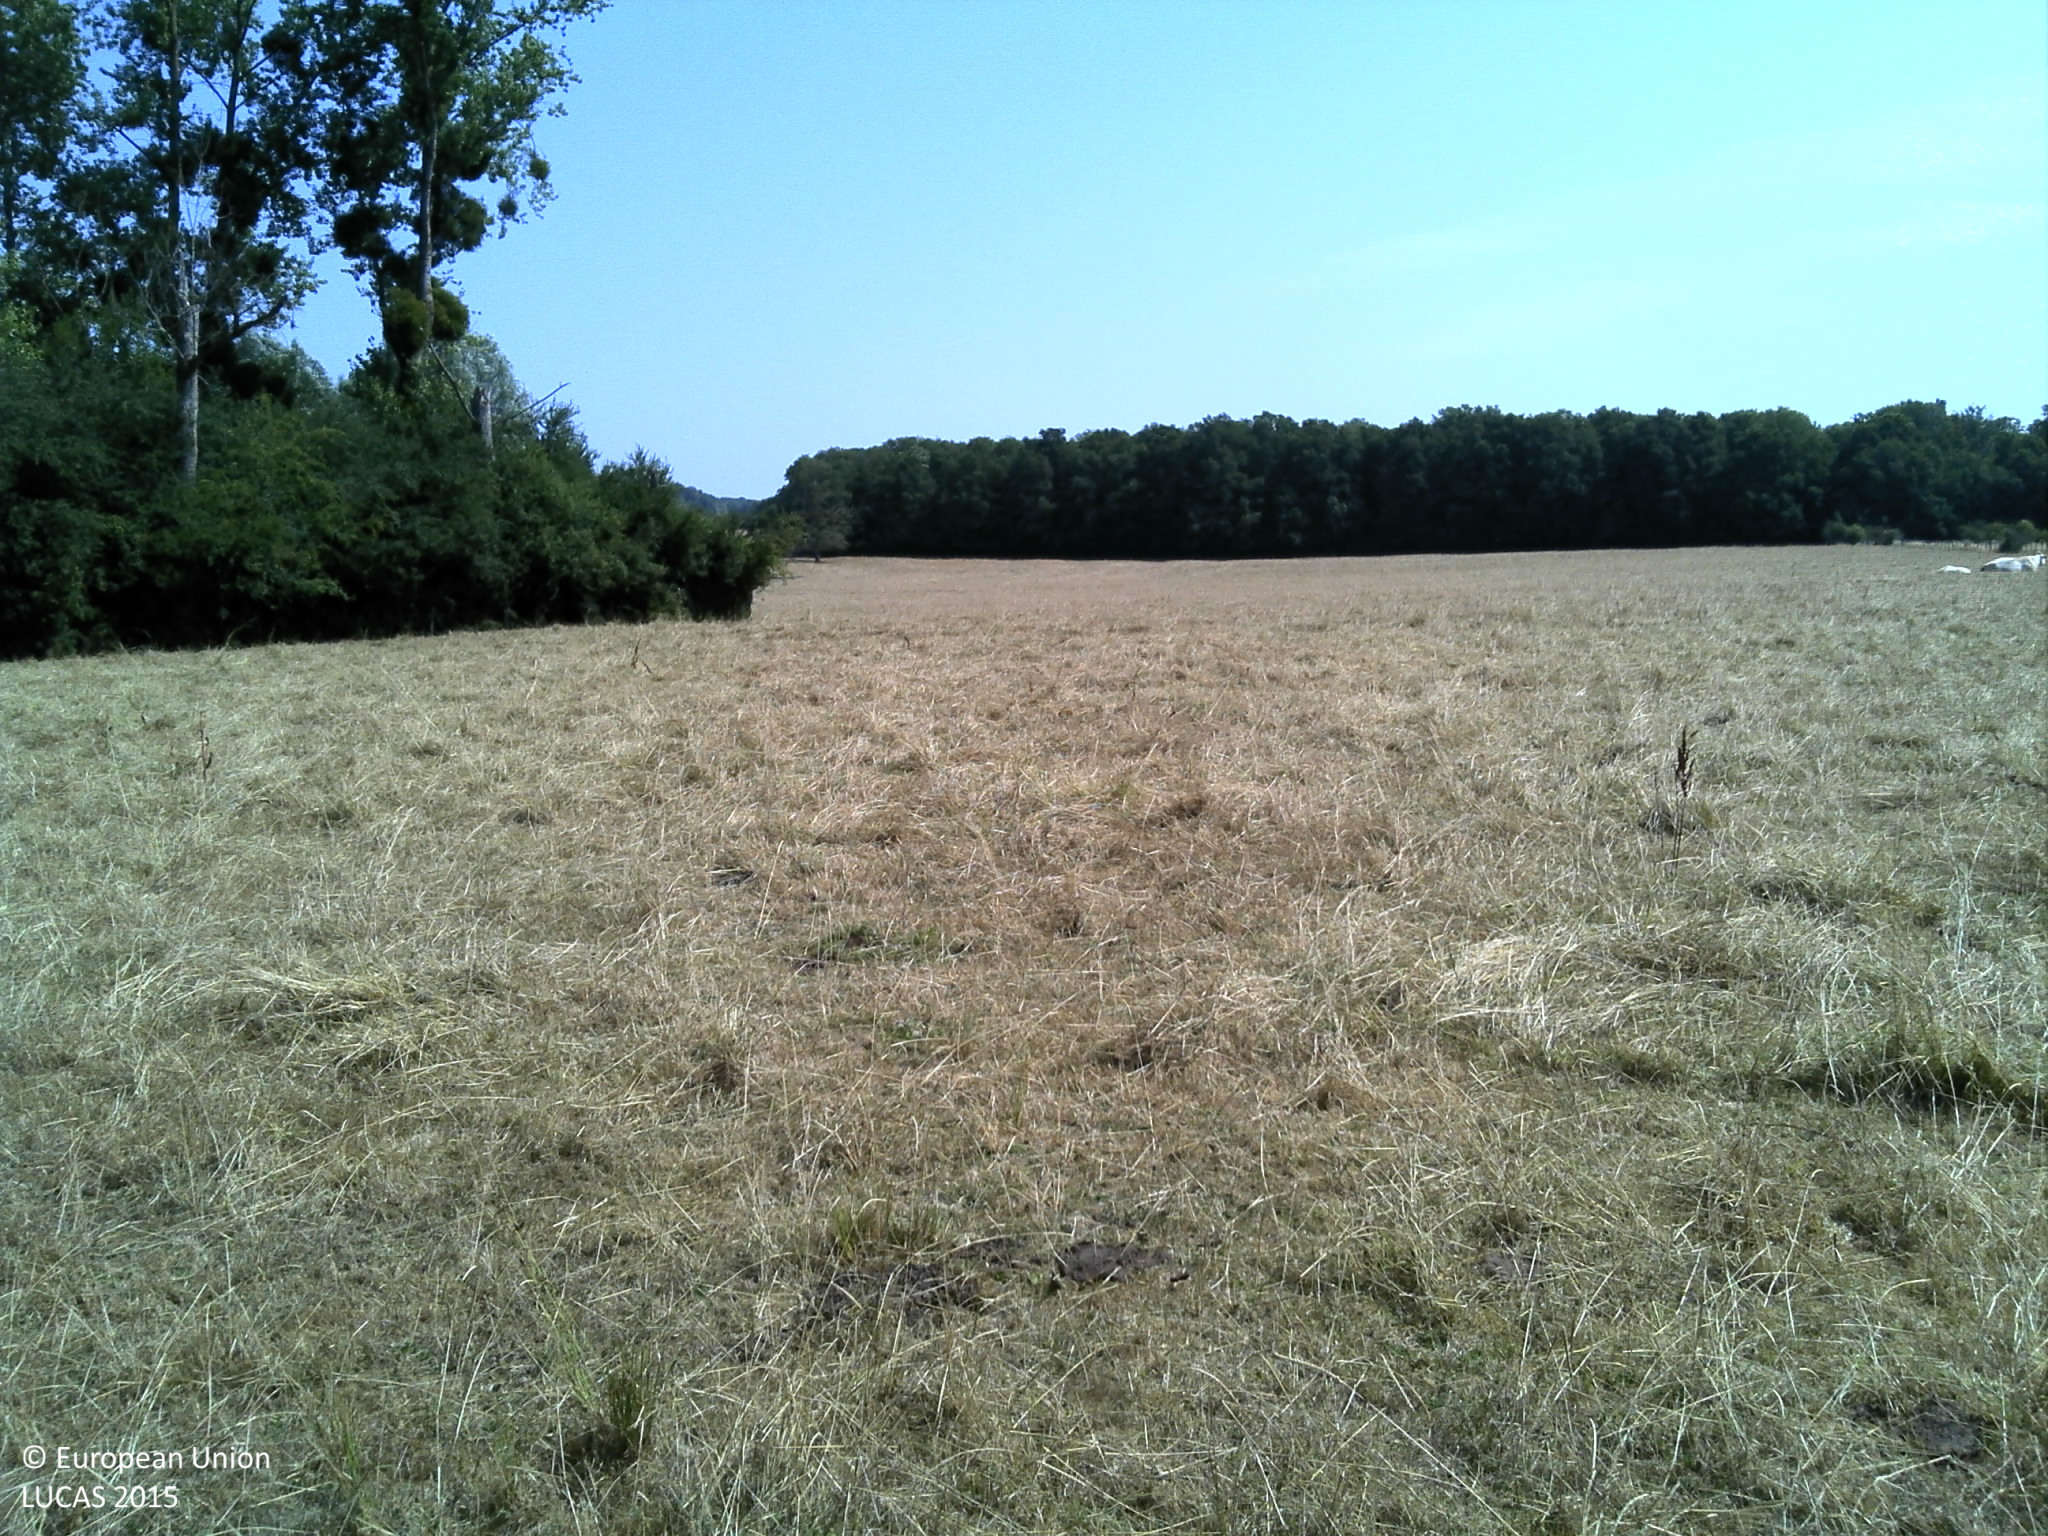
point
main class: Grassland
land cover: Grassland without tree/shrub cover
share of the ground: > 75 %
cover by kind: herbaceous plants 100 %
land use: Agriculture (excluding fallow land and kitchen gardens)
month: July
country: FR
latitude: 48.8249
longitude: 4.8626
